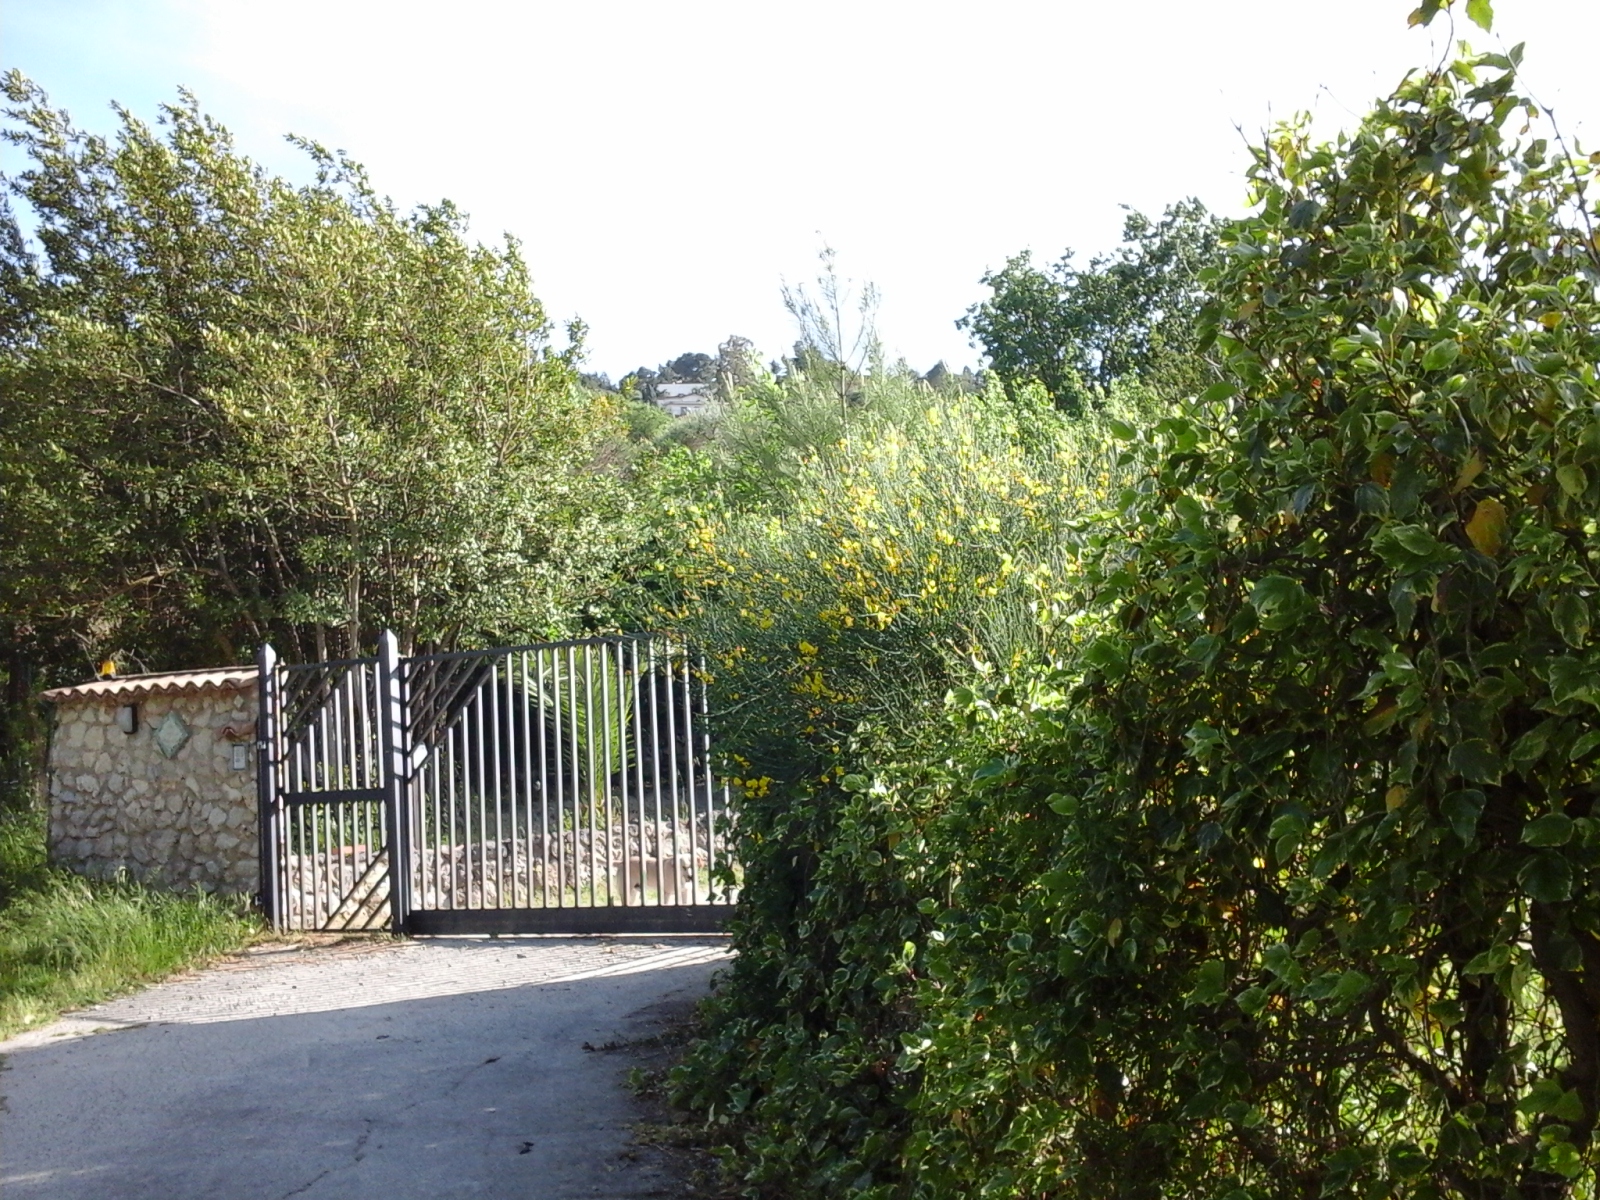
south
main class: Woodland
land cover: Broadleaved woodland
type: broadleaved evergreen forest
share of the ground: > 75 %
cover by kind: broadleaved forest trees 70 %, shrubs 20 %, coniferous forest trees 10 %
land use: Forestry
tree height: > 5 m
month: May
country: IT
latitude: 37.4985
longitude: 14.0306
